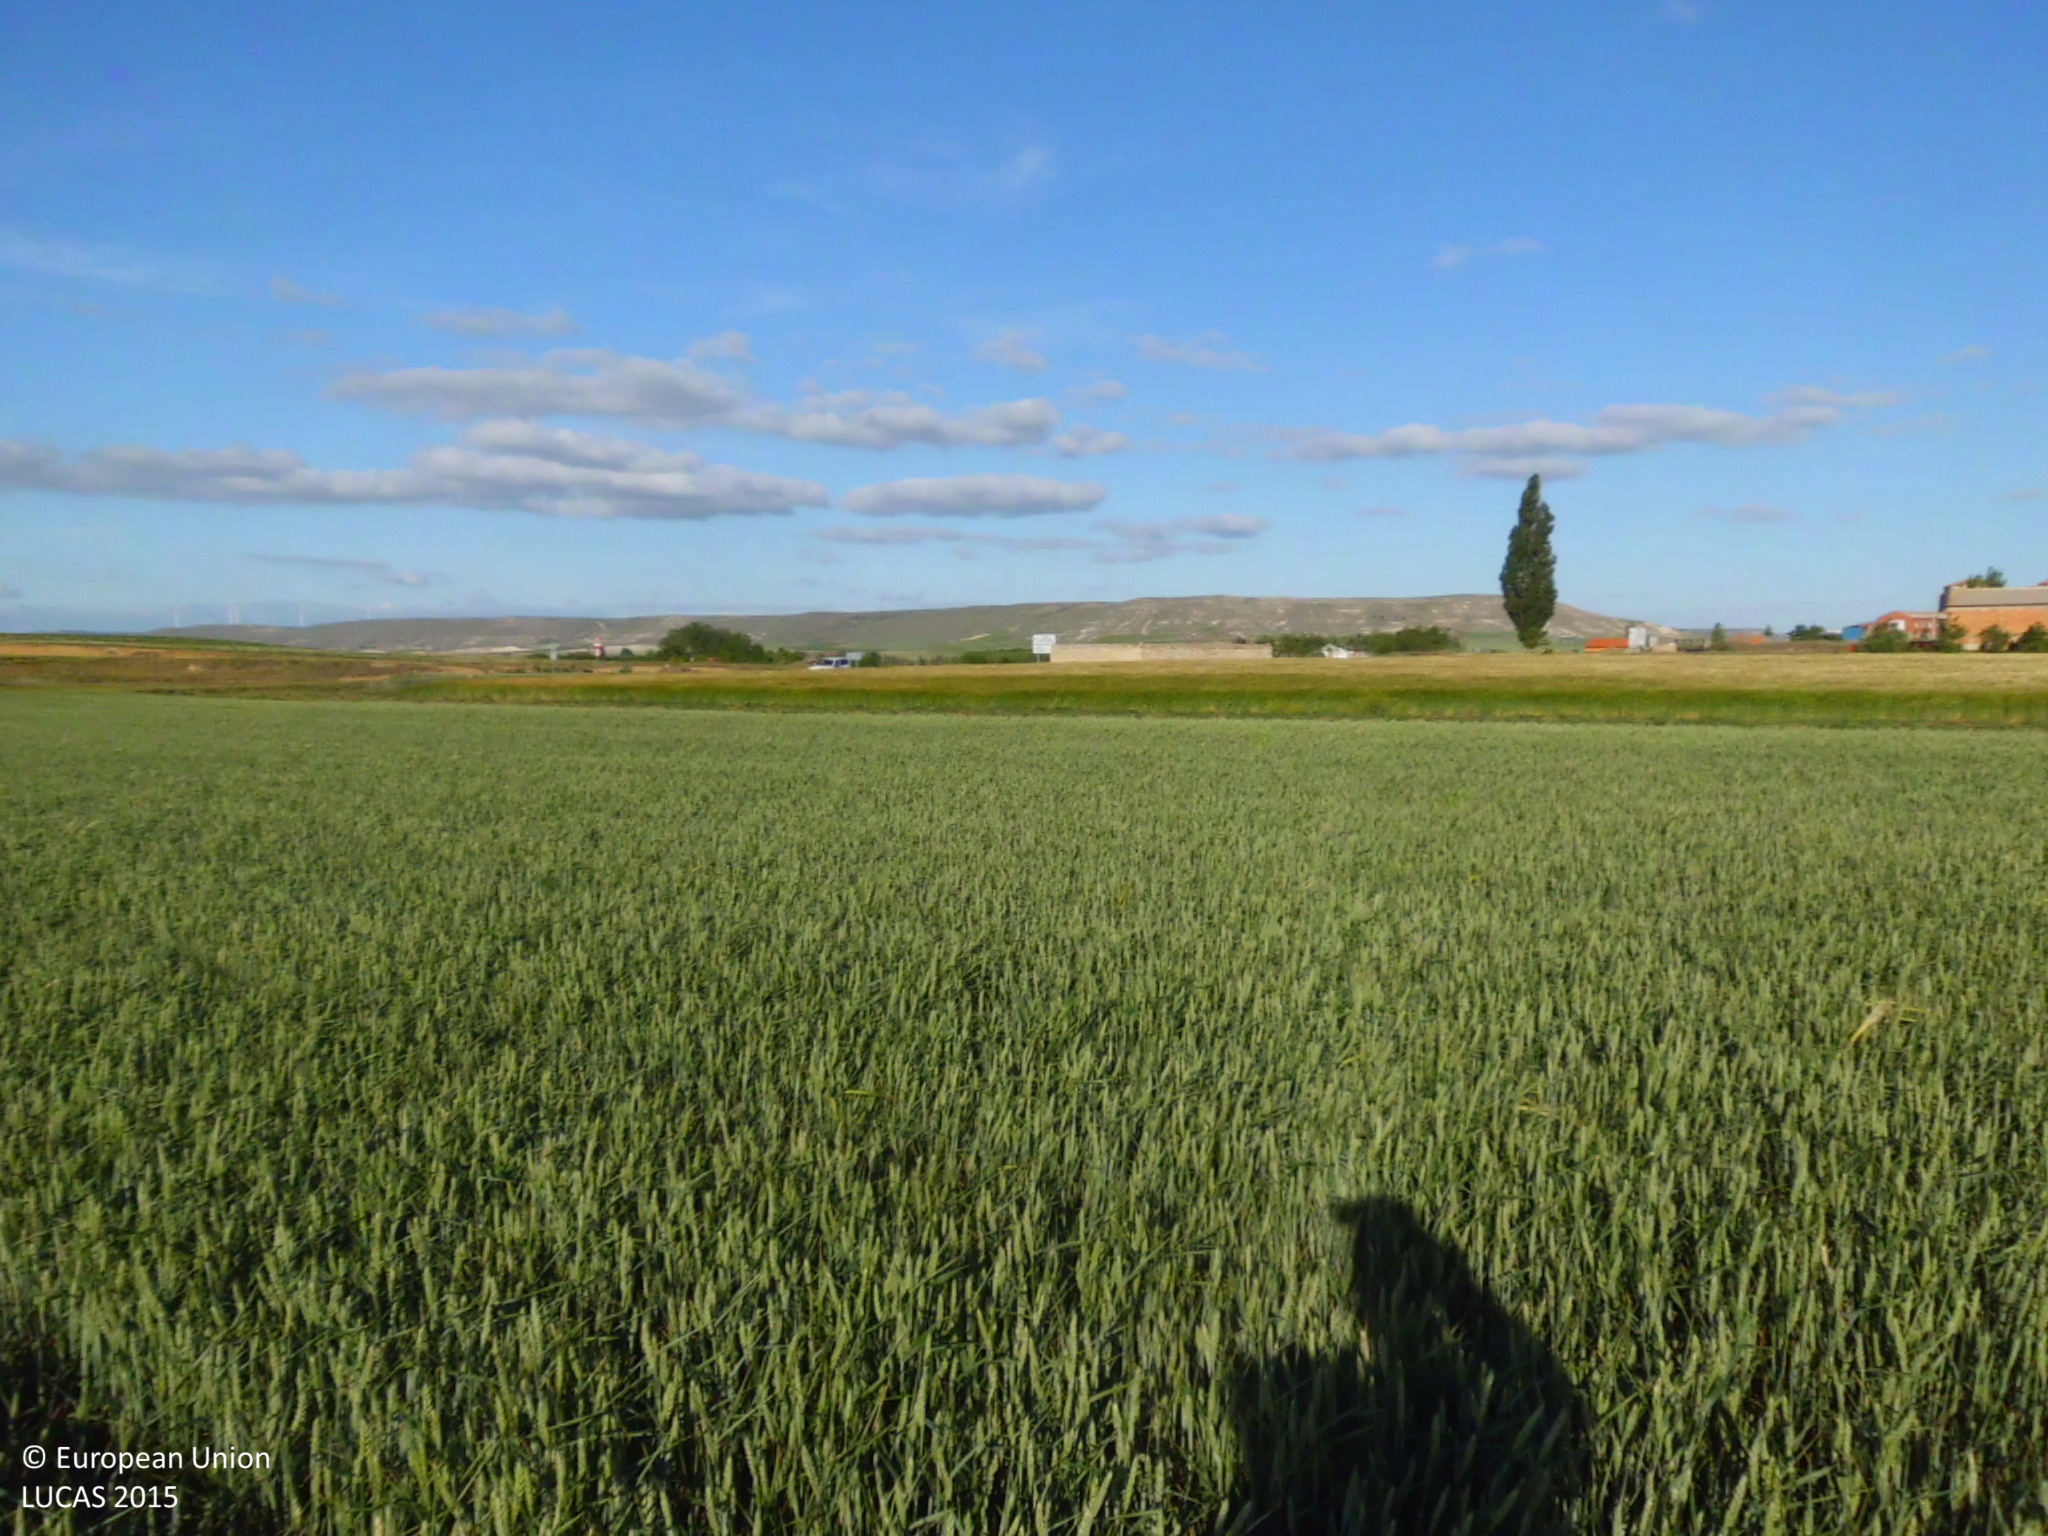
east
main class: Cropland
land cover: Common wheat
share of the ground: > 75 %
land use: Agriculture (excluding fallow land and kitchen gardens)
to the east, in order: Common wheat; Other leguminous and mixtures for fodder; Barley; Tracks; Grass margins; Common wheat; Artificial constructions in urban areas; Tracks; Grass margins; Spontaneously vegetated surfaces; Paved roads, cycling and walking lanes; Grassland without tree/shrub cover
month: May
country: ES
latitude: 42.3101
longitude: -4.1771
